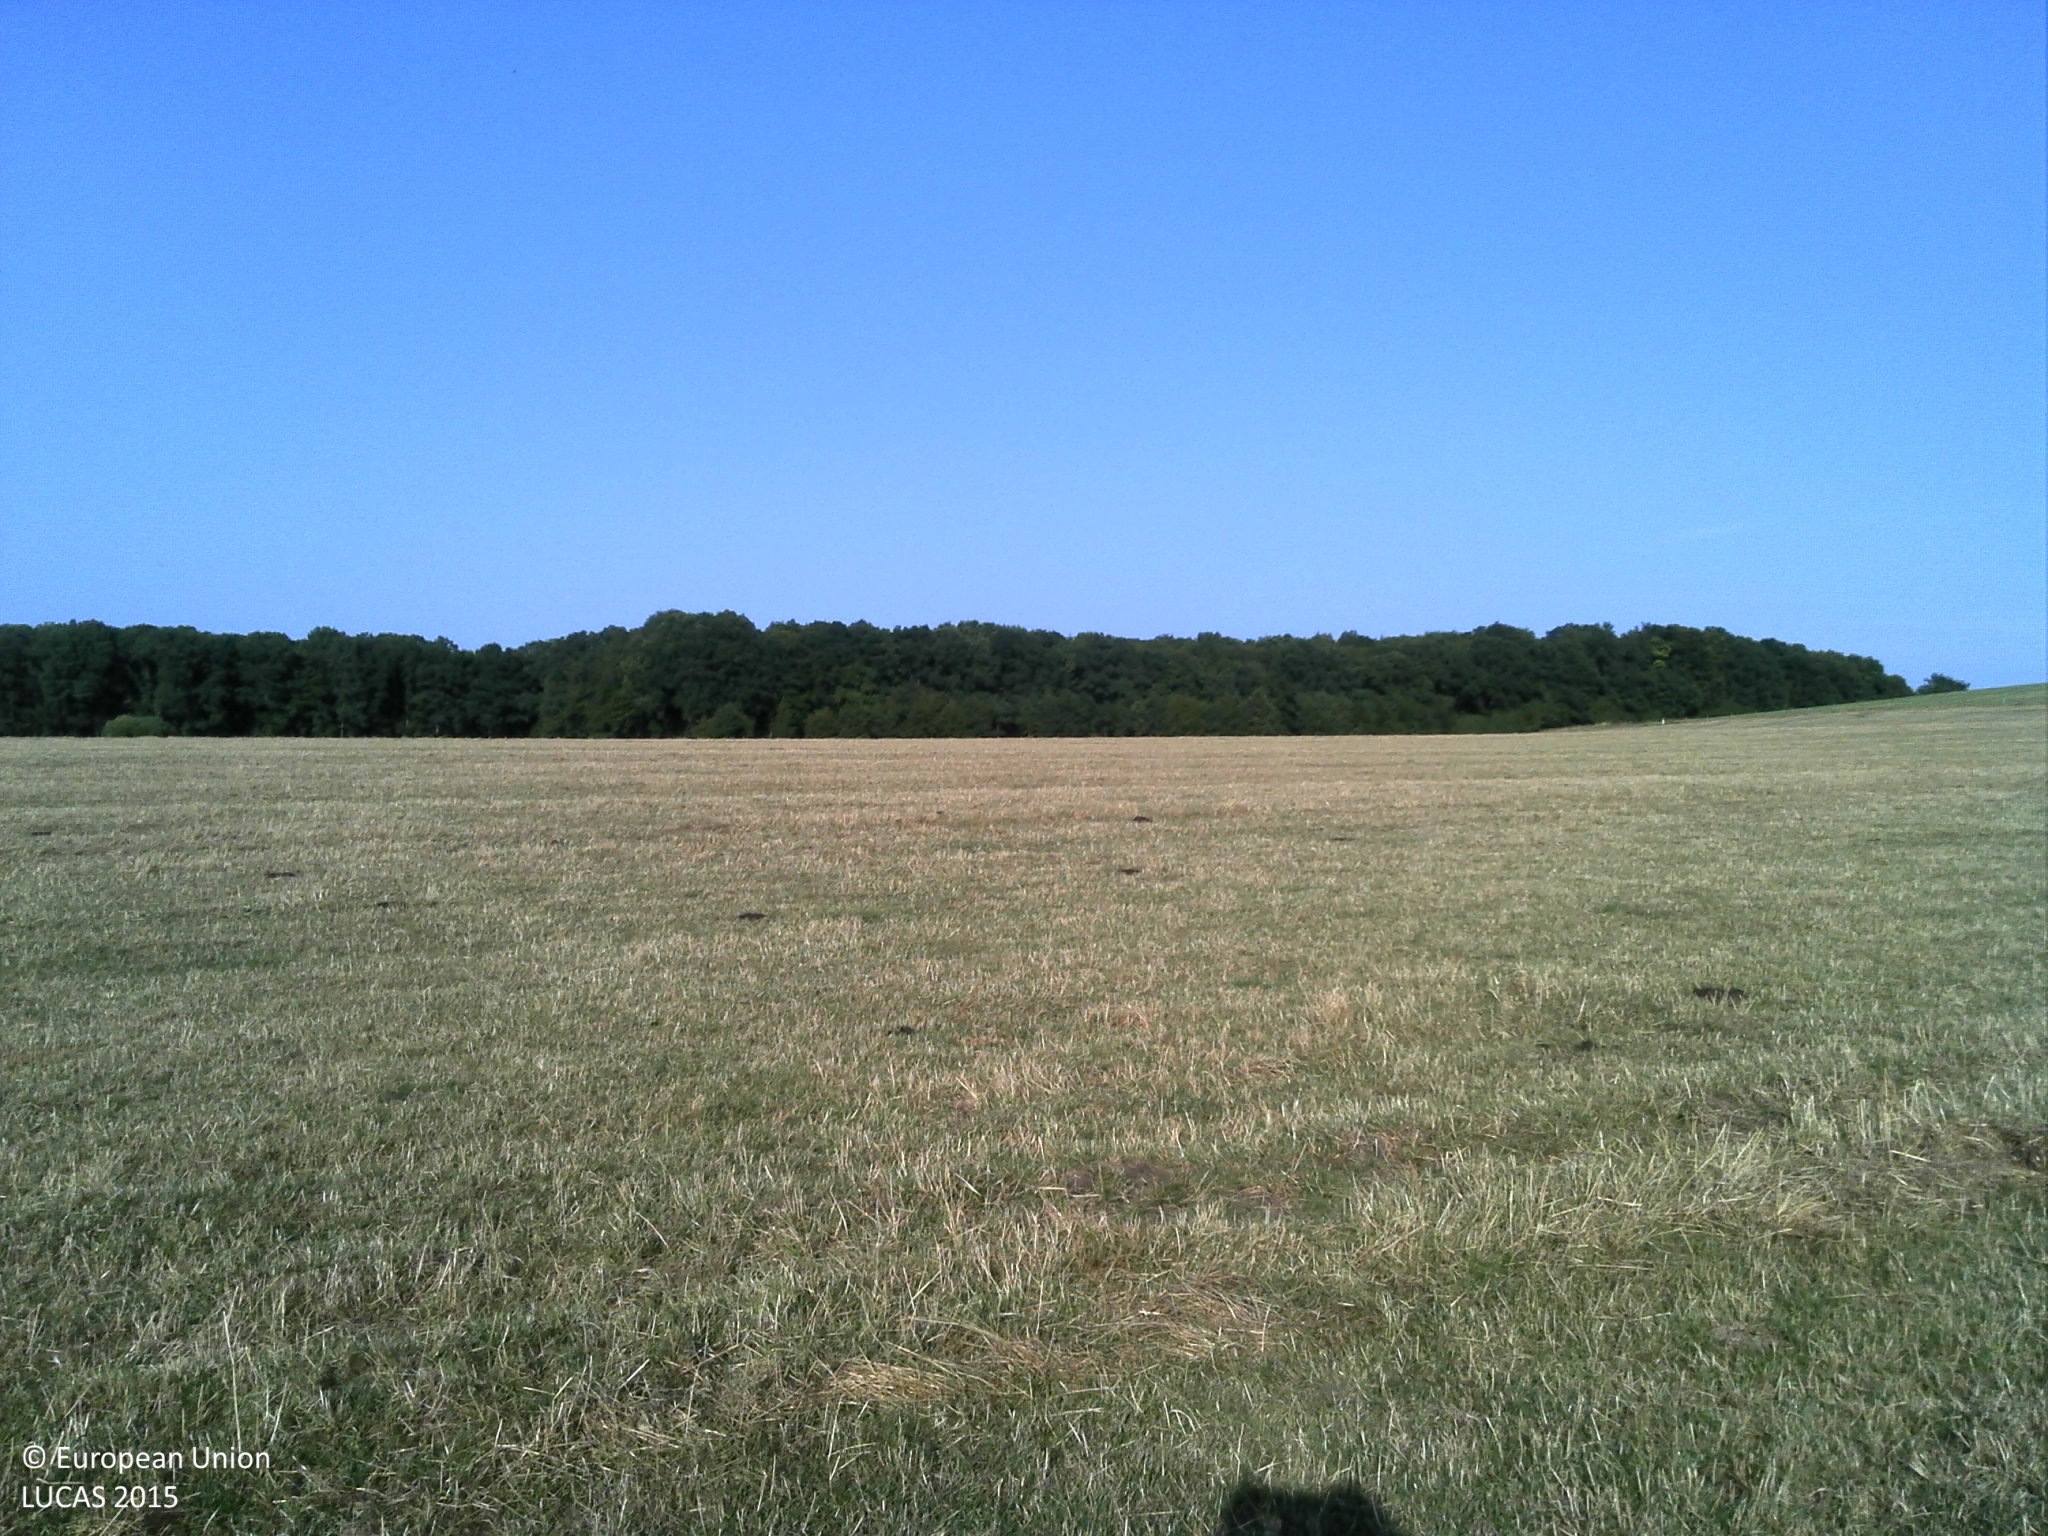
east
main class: Grassland
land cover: Grassland without tree/shrub cover
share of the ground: > 75 %
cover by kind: herbaceous plants 100 %
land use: Agriculture (excluding fallow land and kitchen gardens)
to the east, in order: Grassland without tree/shrub cover
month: July
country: FR
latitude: 49.0941
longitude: 6.7546
